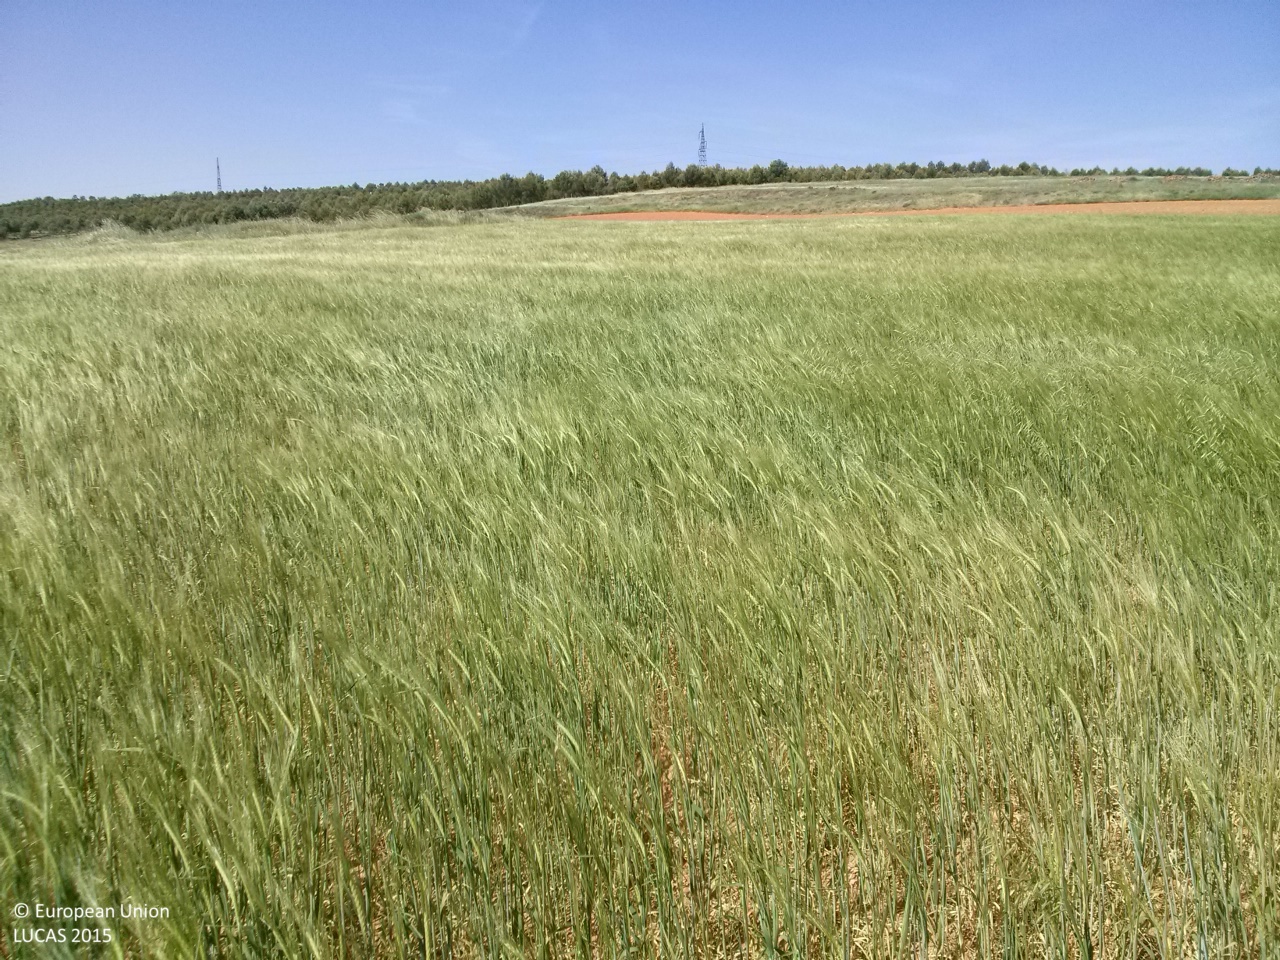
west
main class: Cropland
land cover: Barley
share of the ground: > 75 %
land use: Agriculture (excluding fallow land and kitchen gardens)
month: May
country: ES
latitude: 40.0072
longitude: -2.8257
